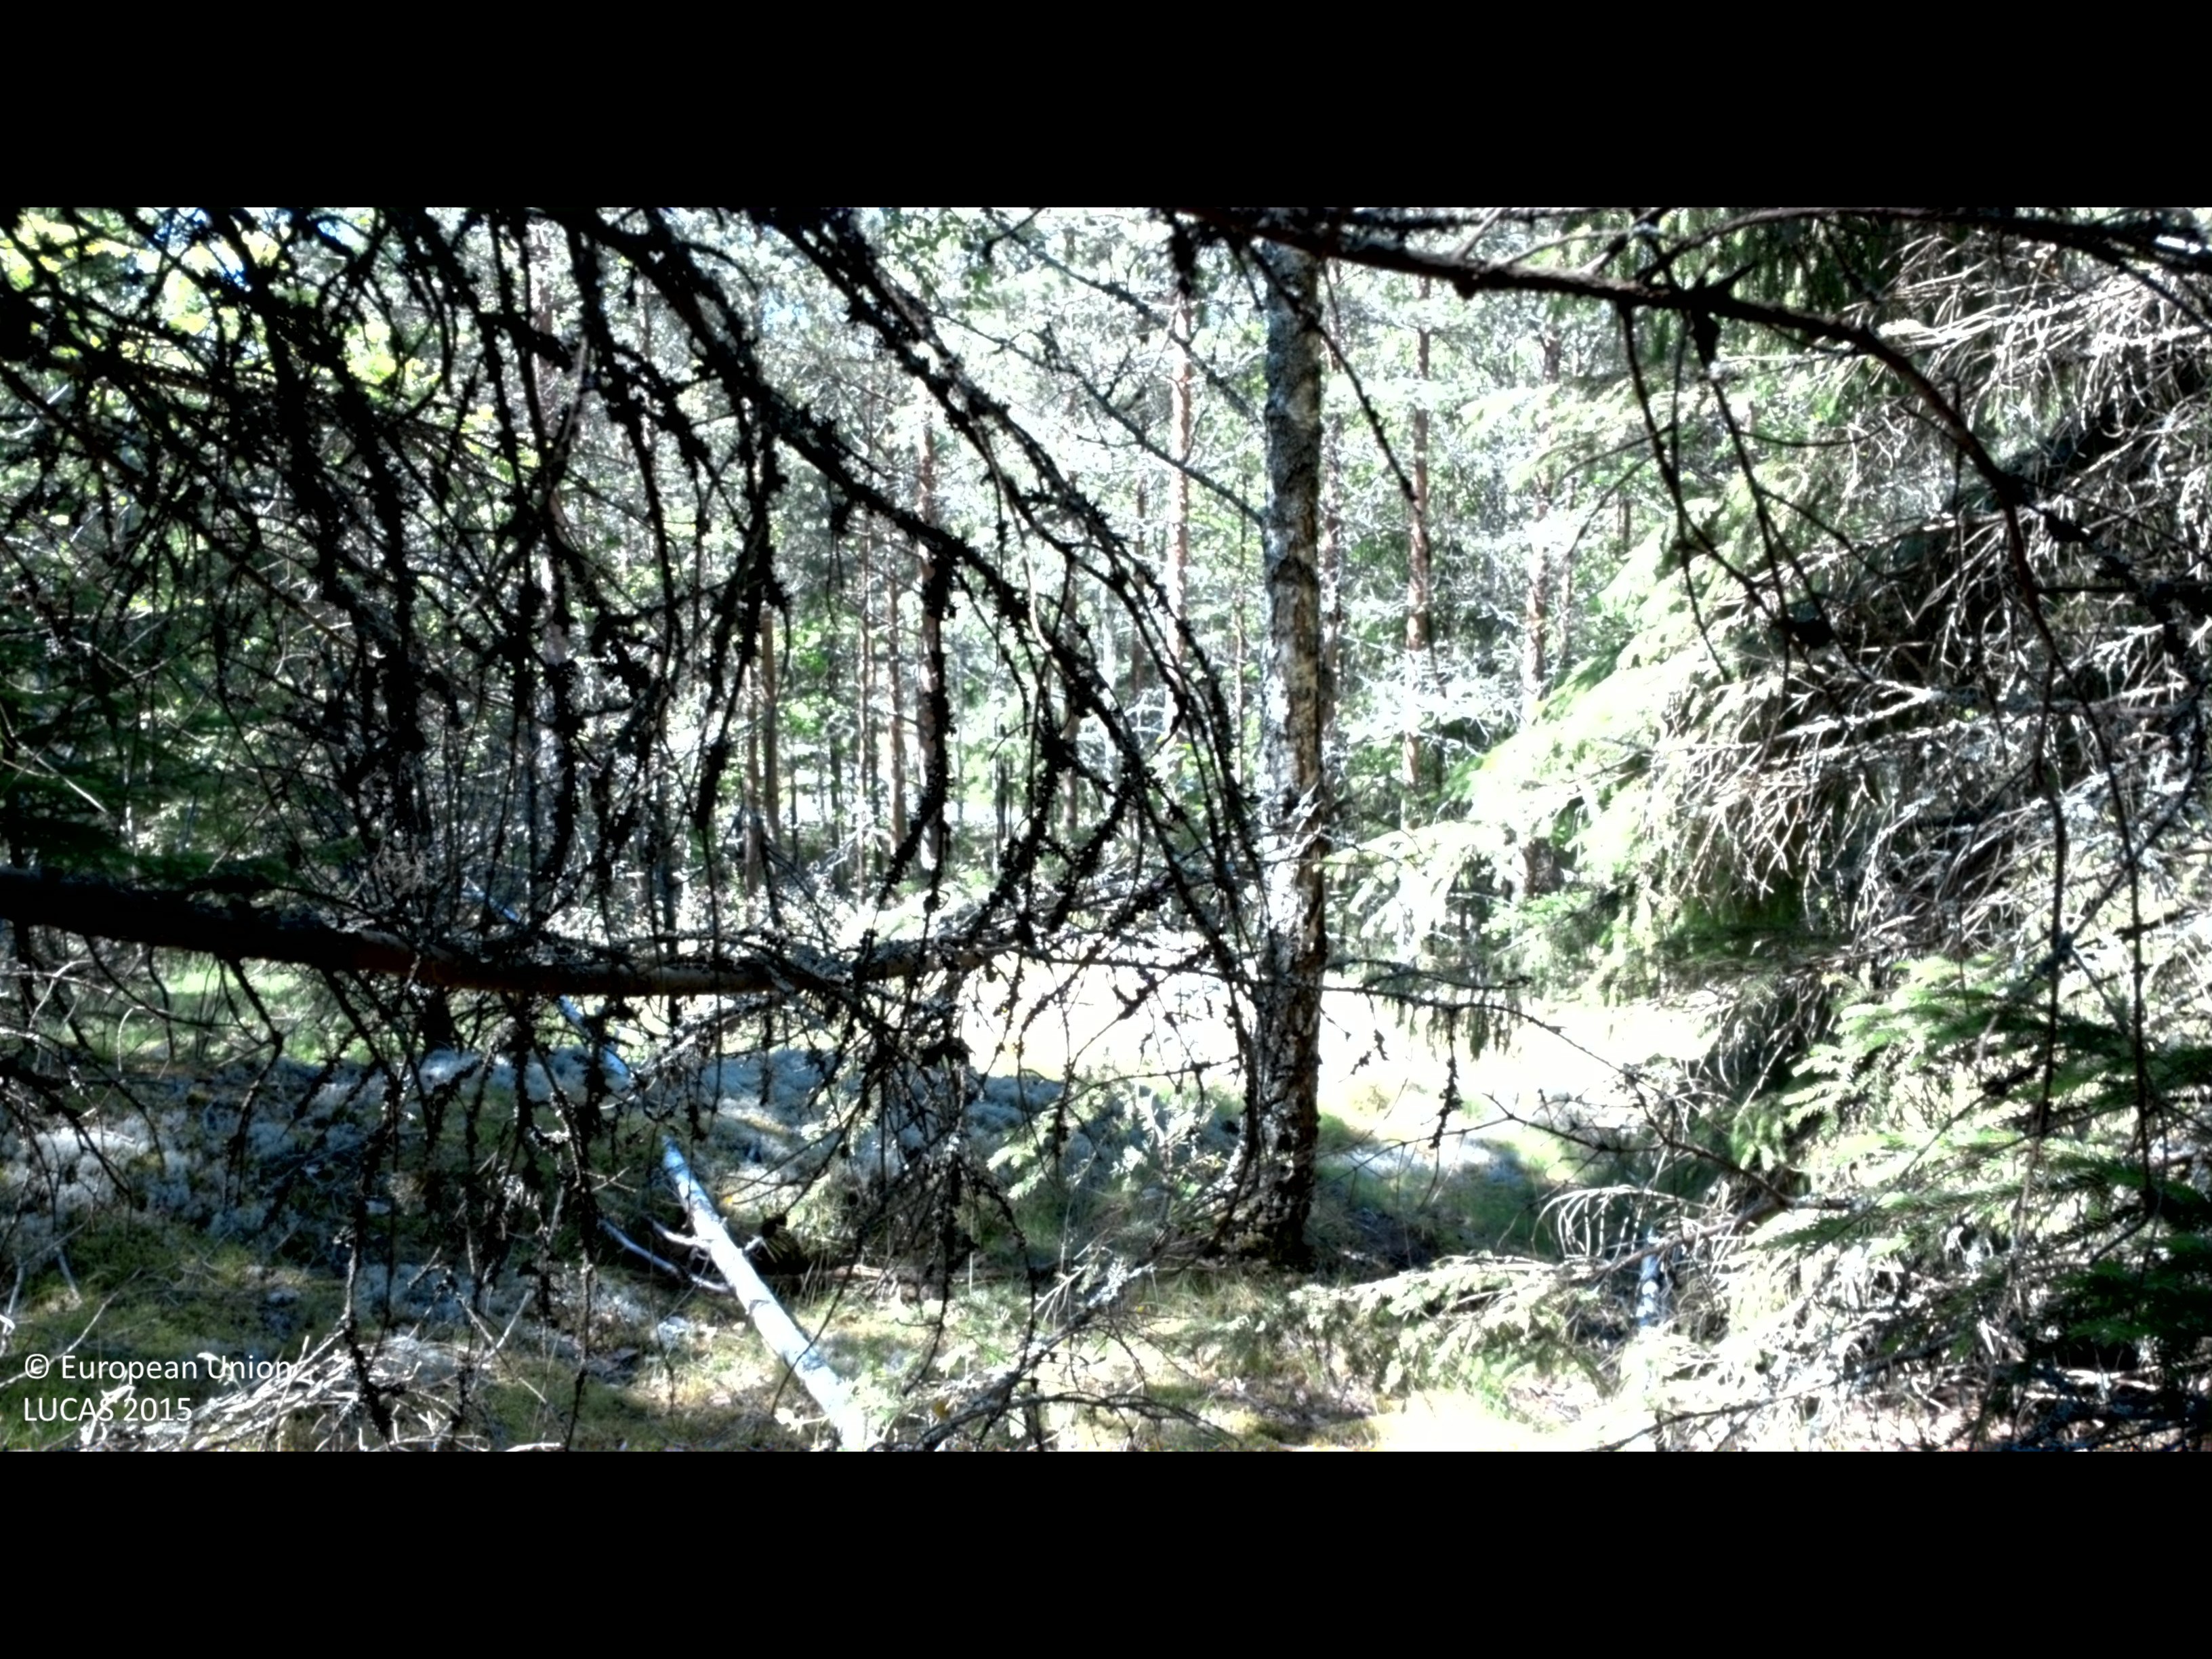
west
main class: Woodland
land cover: Spruce dominated coniferous woodland
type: boreal forest
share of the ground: > 75 %
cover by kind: coniferous forest trees 70 %, broadleaved forest trees 15 %, lichens and mosses 10 %, shrubs 5 %
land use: Forestry
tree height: > 5 m
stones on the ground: < 10 %
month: July
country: SE
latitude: 58.1831
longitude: 16.6129
